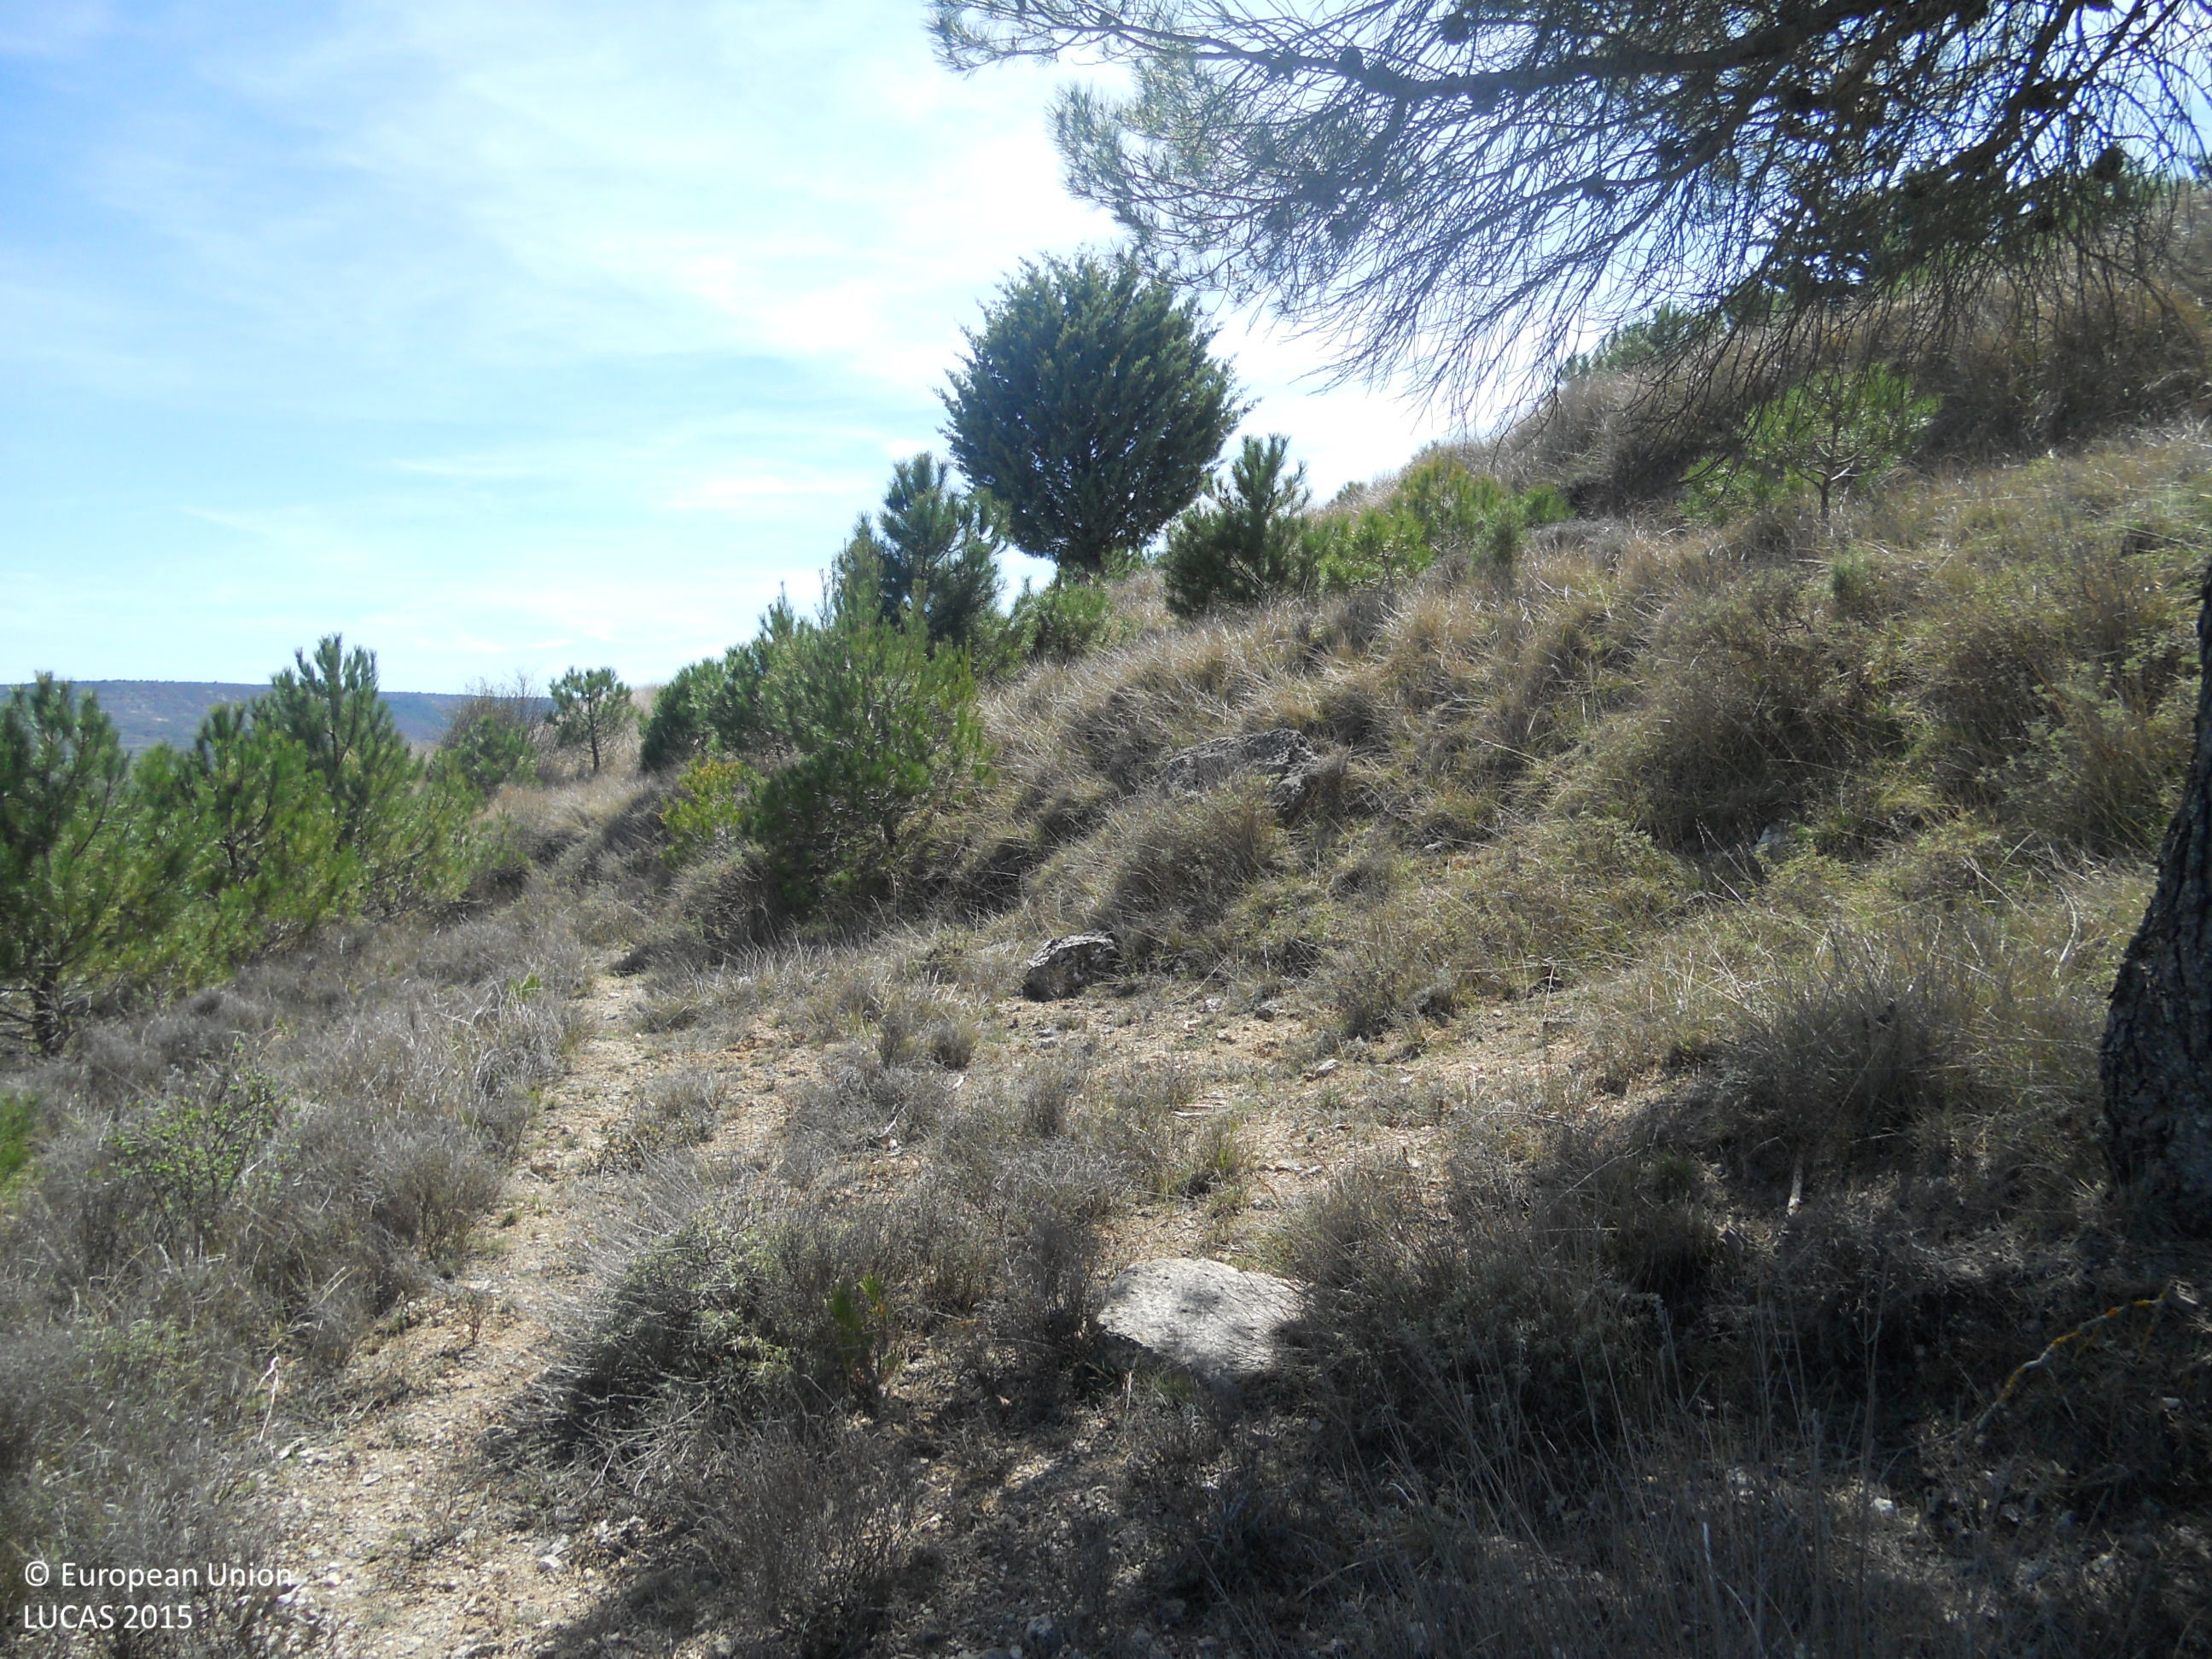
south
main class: Woodland
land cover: Pine dominated coniferous woodland
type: coniferous forest of the mediterranean region
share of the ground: 50 - 75 %
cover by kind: coniferous forest trees 65 %, herbaceous plants 20 %, shrubs 10 %, consolidated bare surface 5 %
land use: Forestry
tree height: > 5 m
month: April
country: ES
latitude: 42.1692
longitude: -4.2667
